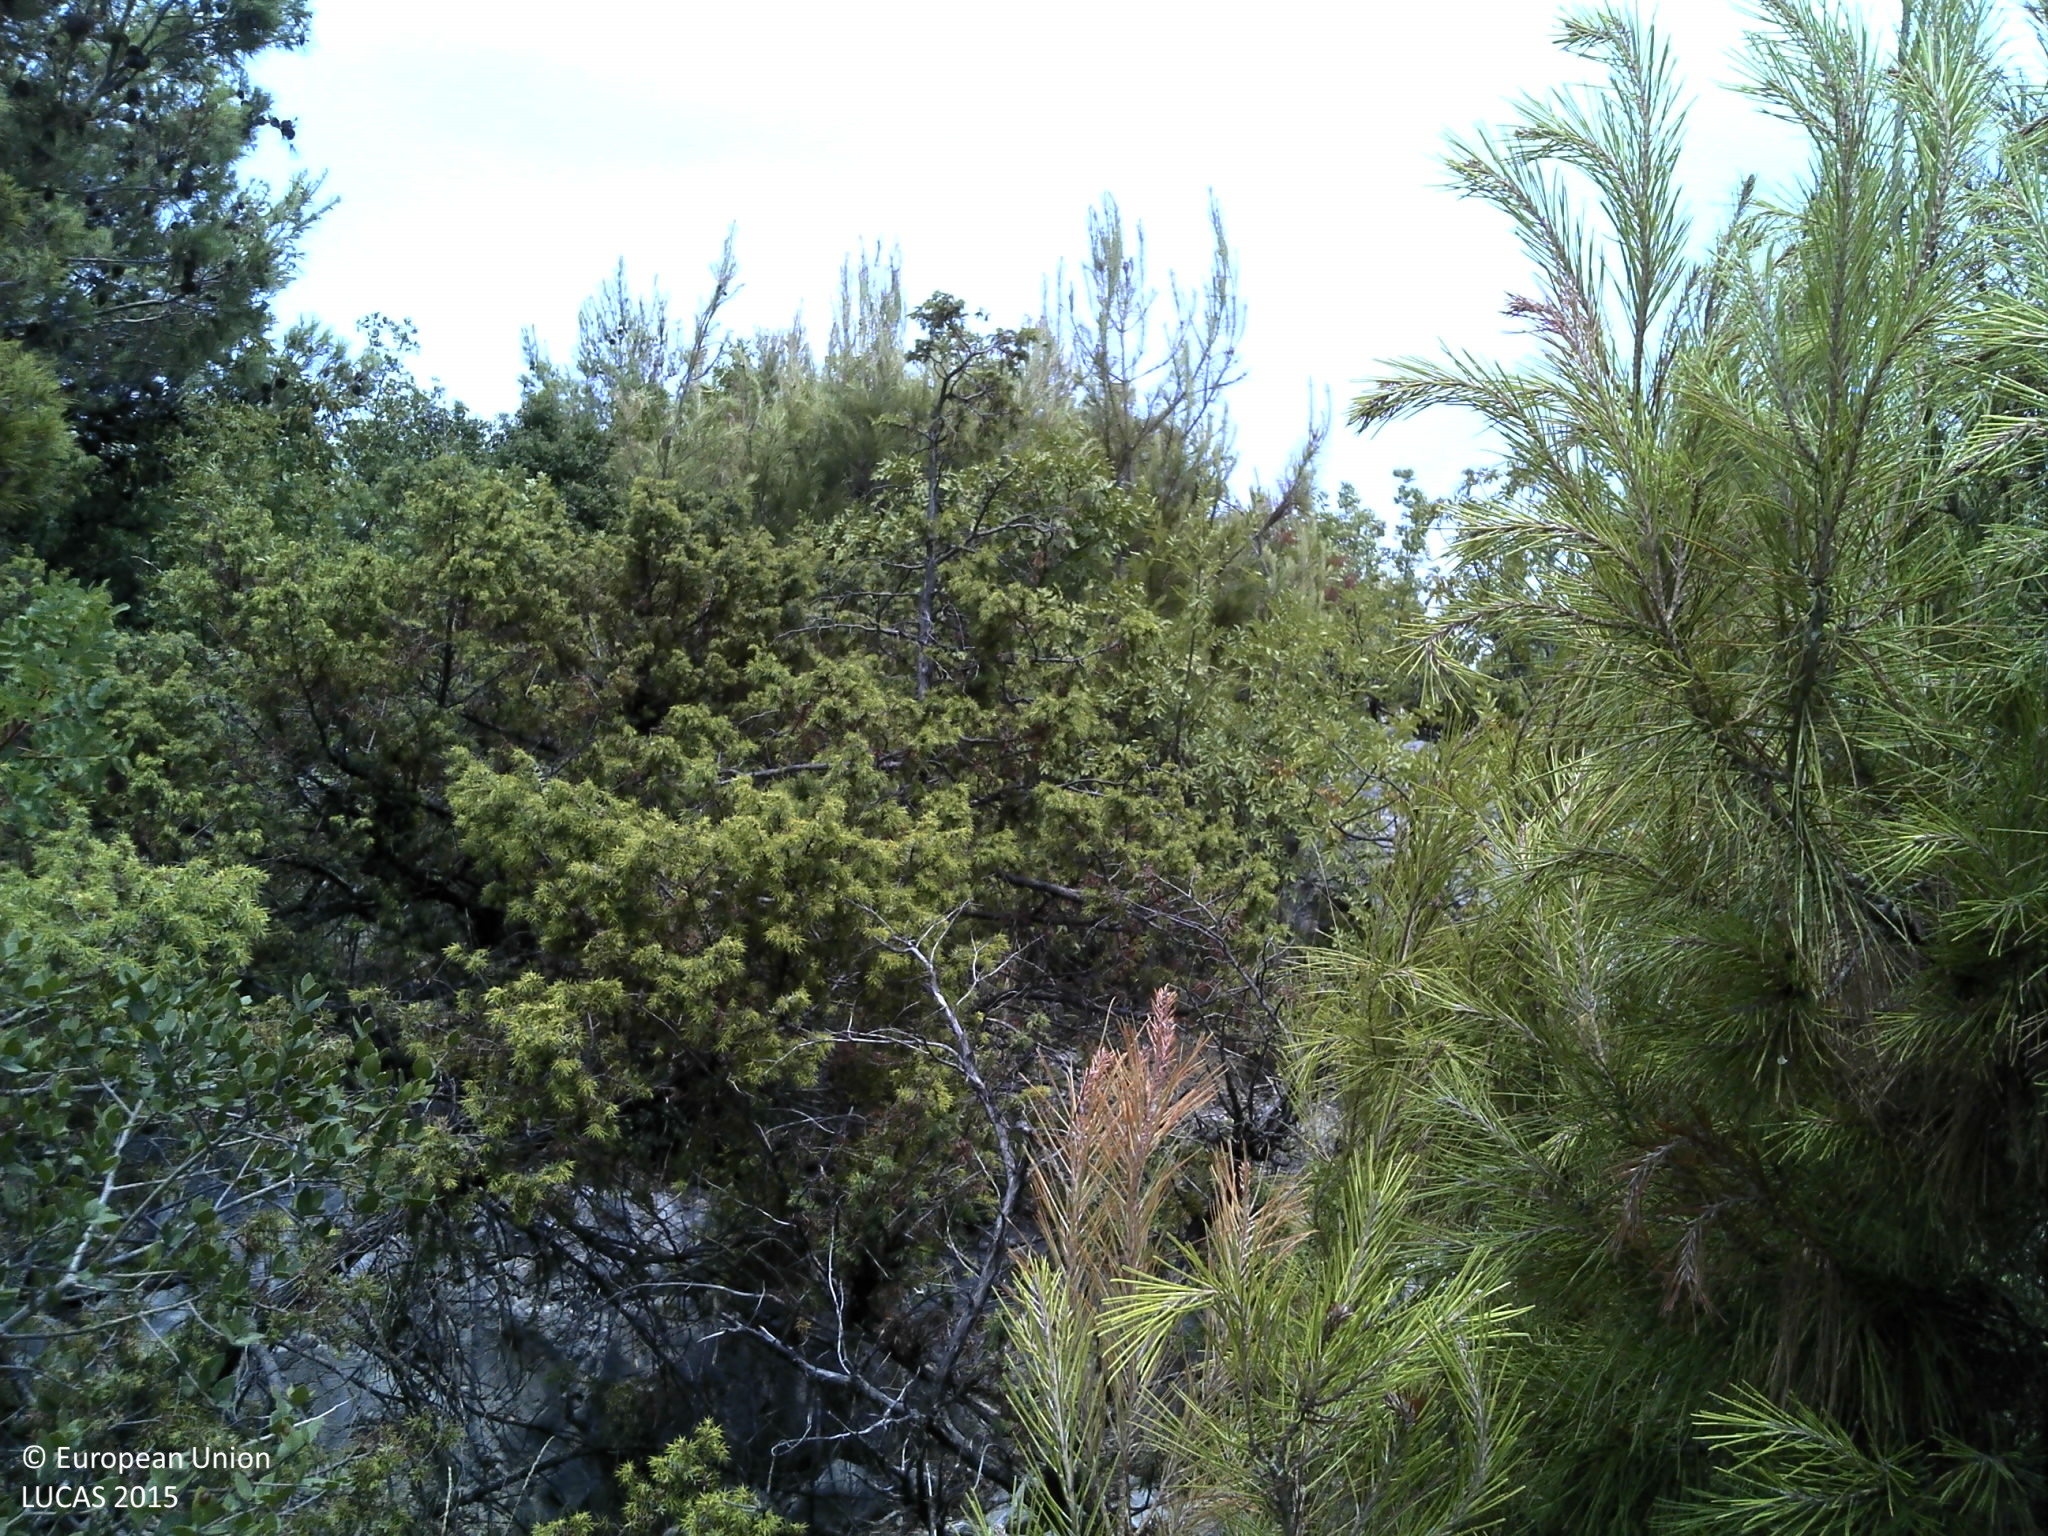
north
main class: Woodland
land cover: Pine dominated mixed woodland
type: coniferous forest of the mediterranean region
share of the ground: 50 - 75 %
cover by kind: coniferous forest trees 40 %, broadleaved forest trees 20 %, shrubs 20 %, consolidated bare surface 20 %
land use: Abandoned areas
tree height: > 5 m
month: August
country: HR
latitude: 43.0936
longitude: 17.5958
